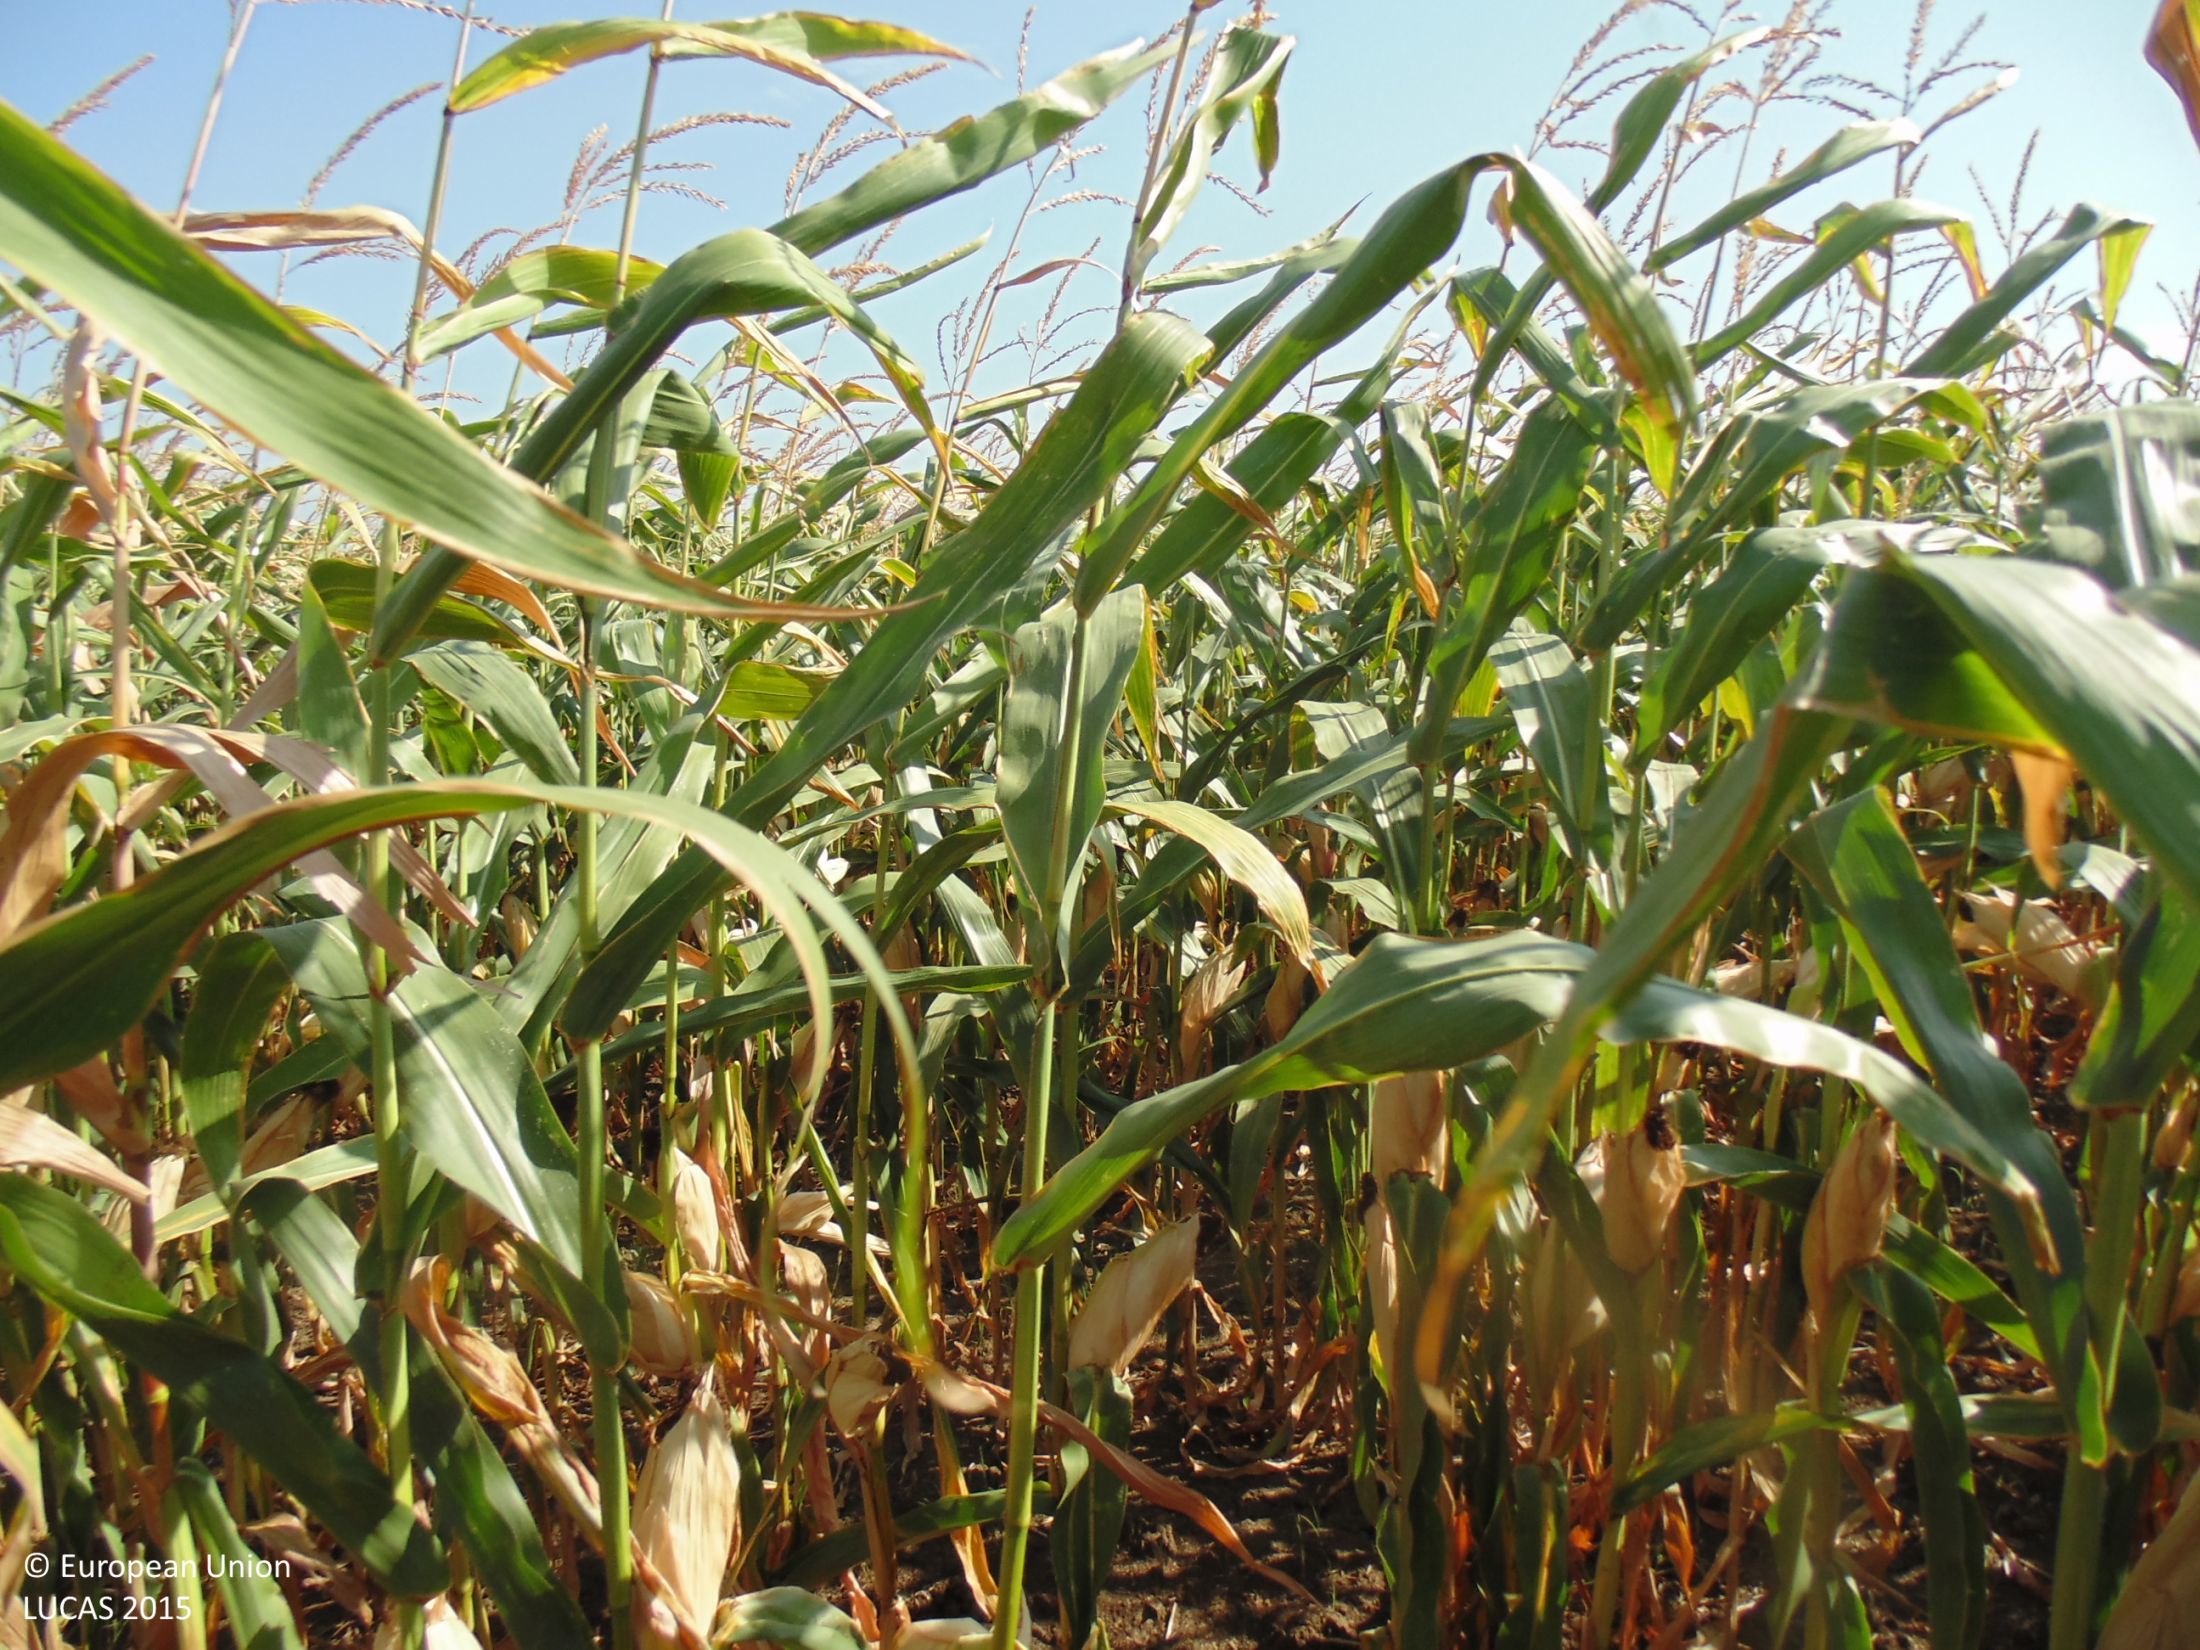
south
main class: Cropland
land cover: Maize
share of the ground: > 75 %
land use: Agriculture (excluding fallow land and kitchen gardens)
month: August
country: BG
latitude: 43.5350
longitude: 28.3090
